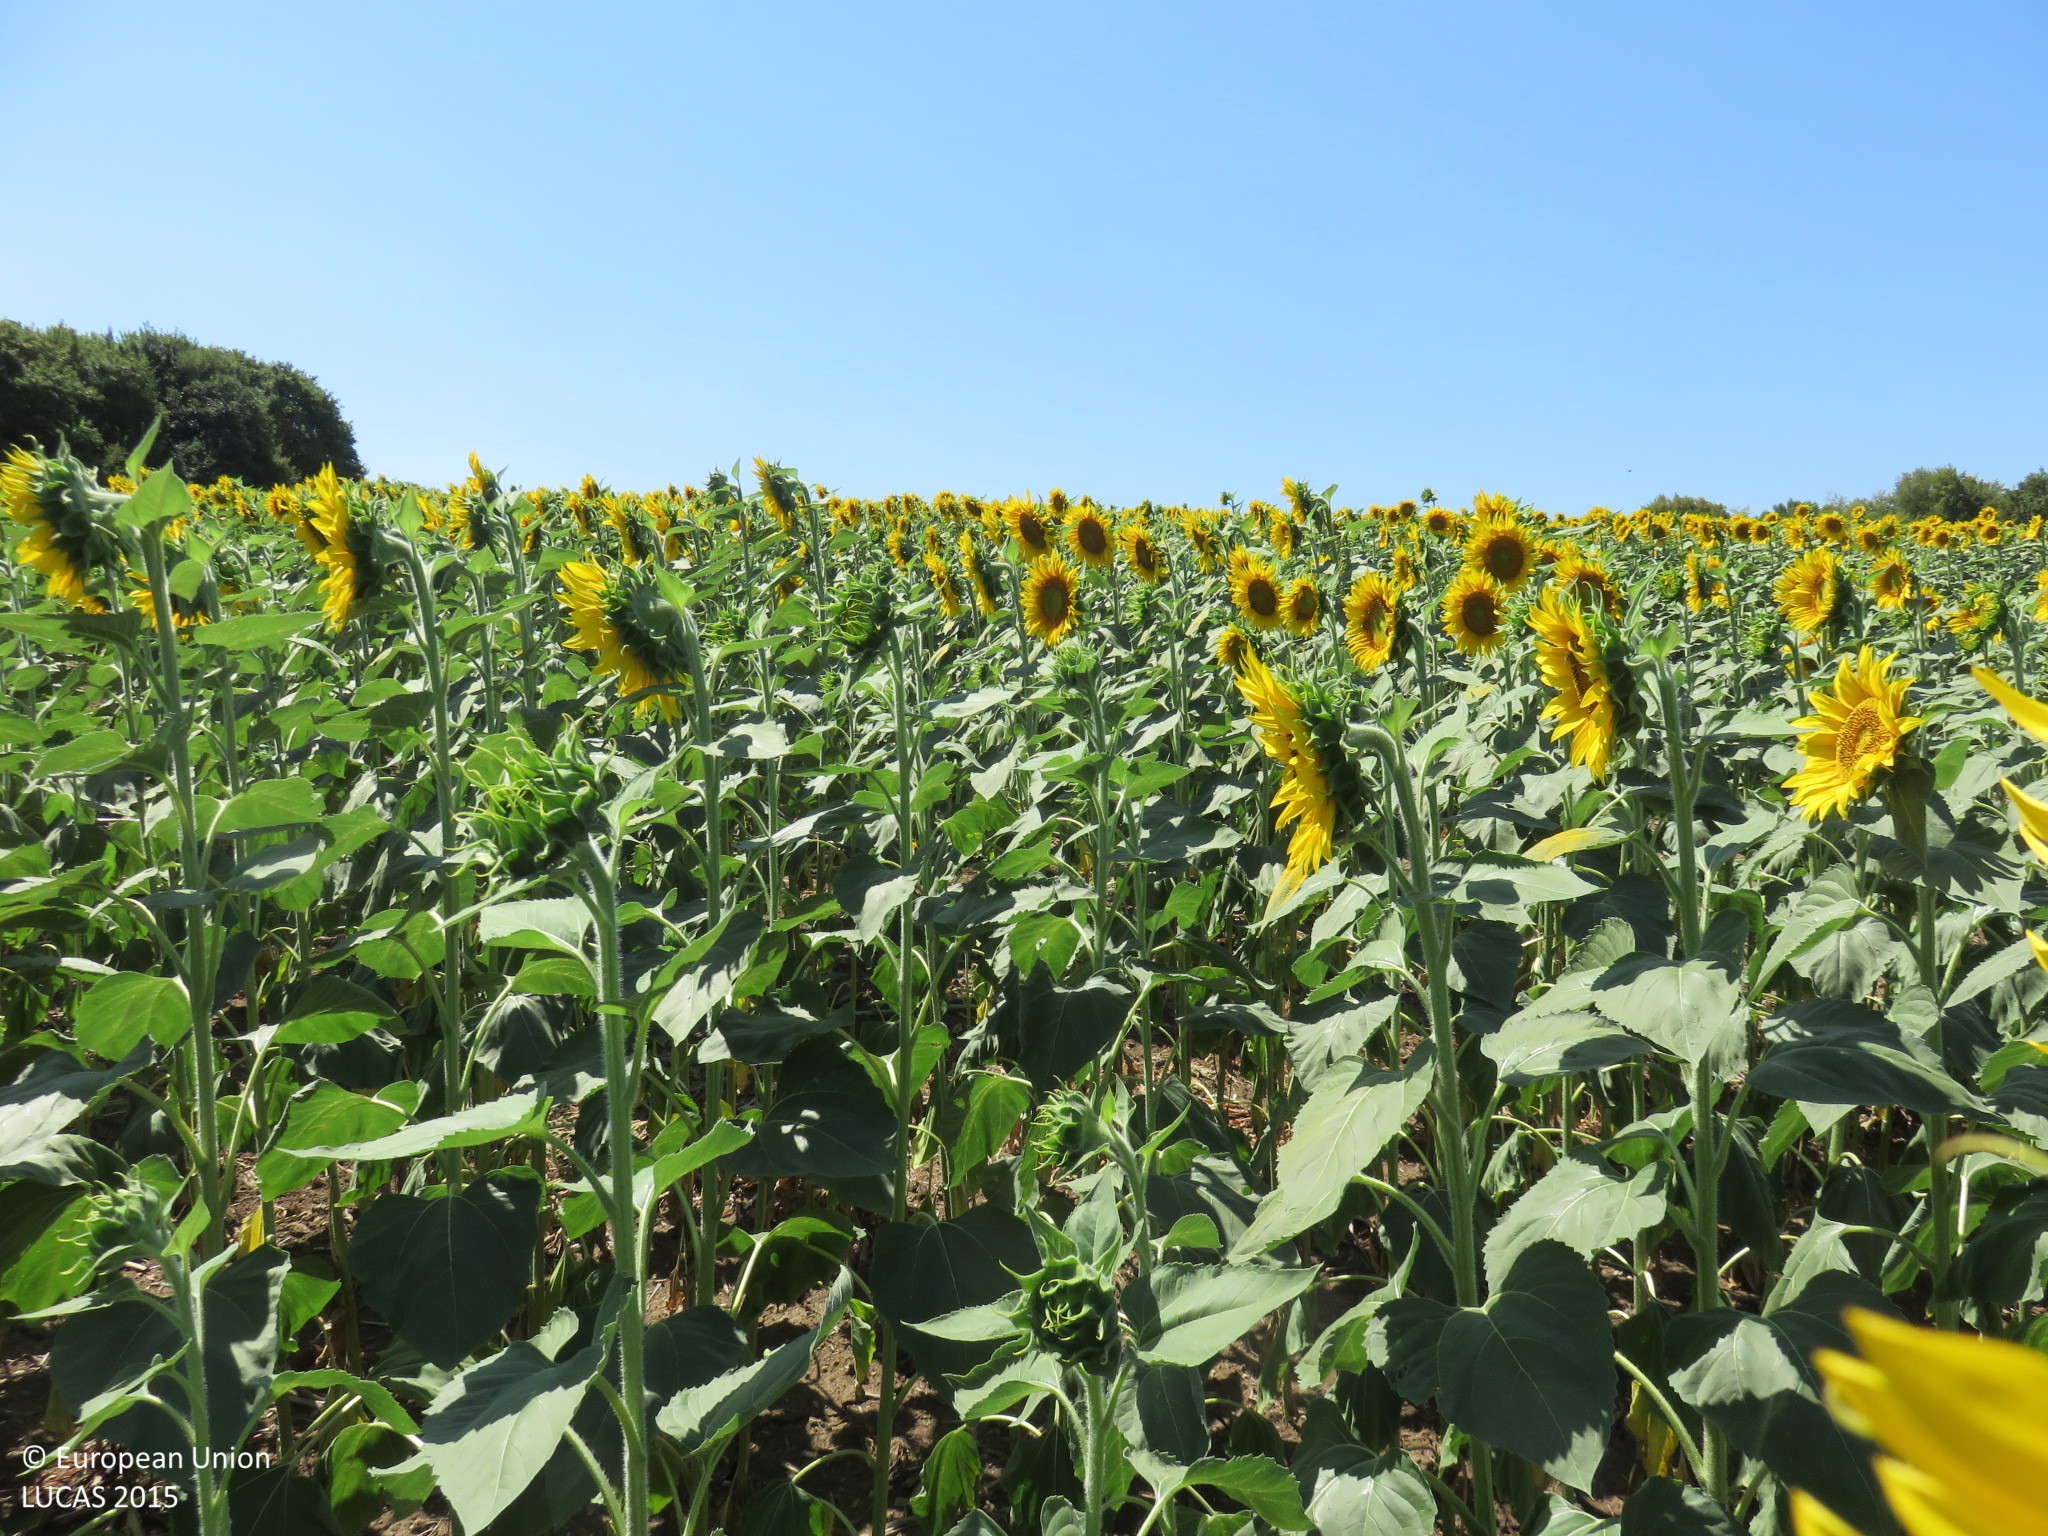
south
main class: Cropland
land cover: Sunflower
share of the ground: > 75 %
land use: Agriculture (excluding fallow land and kitchen gardens)
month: July
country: BG
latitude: 43.2407
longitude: 25.0820
